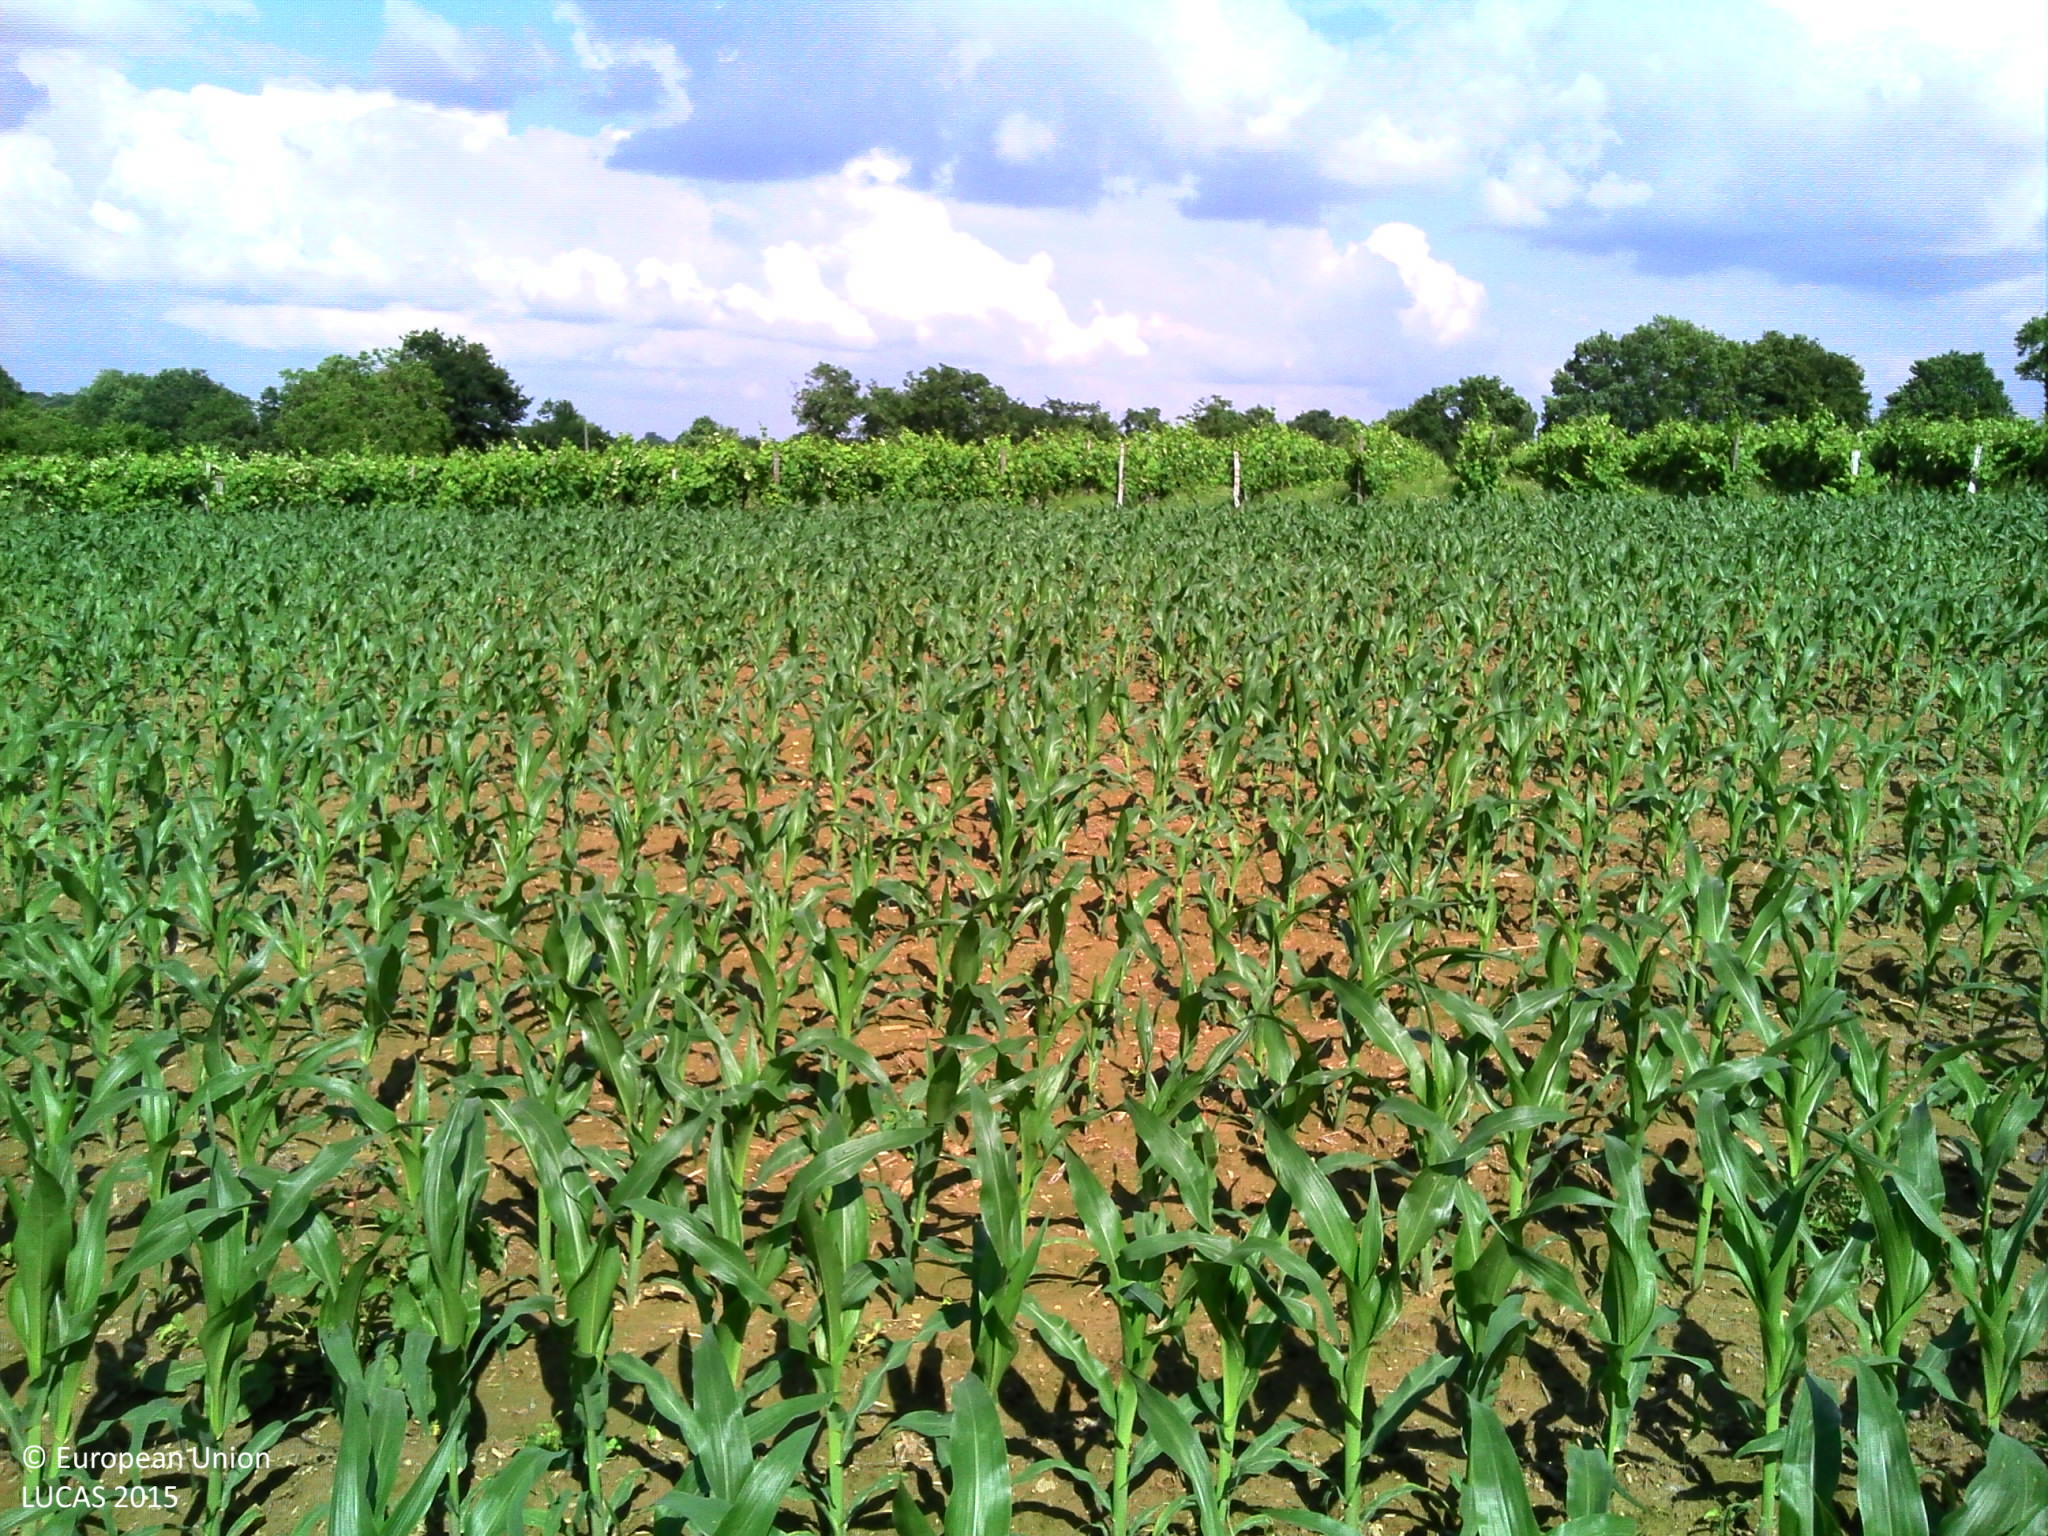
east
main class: Cropland
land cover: Maize
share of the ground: 25 - 50 %
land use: Agriculture (excluding fallow land and kitchen gardens)
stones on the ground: < 10 %
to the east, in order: Maize; Grassland without tree/shrub cover; Vineyards; Abandoned hedges; Electric lines; Ditches and canals; Grass margins; Paved roads, cycling and walking lanes; Grass margins; Ditches and canals; Spontaneously vegetated surfaces; Maize; Tomatoes; Managed hedges; Grass margins; Tracks; Grass margins; Managed hedges; Grassland without tree/shrub cover
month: June
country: FR
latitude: 43.8064
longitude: -0.2395
